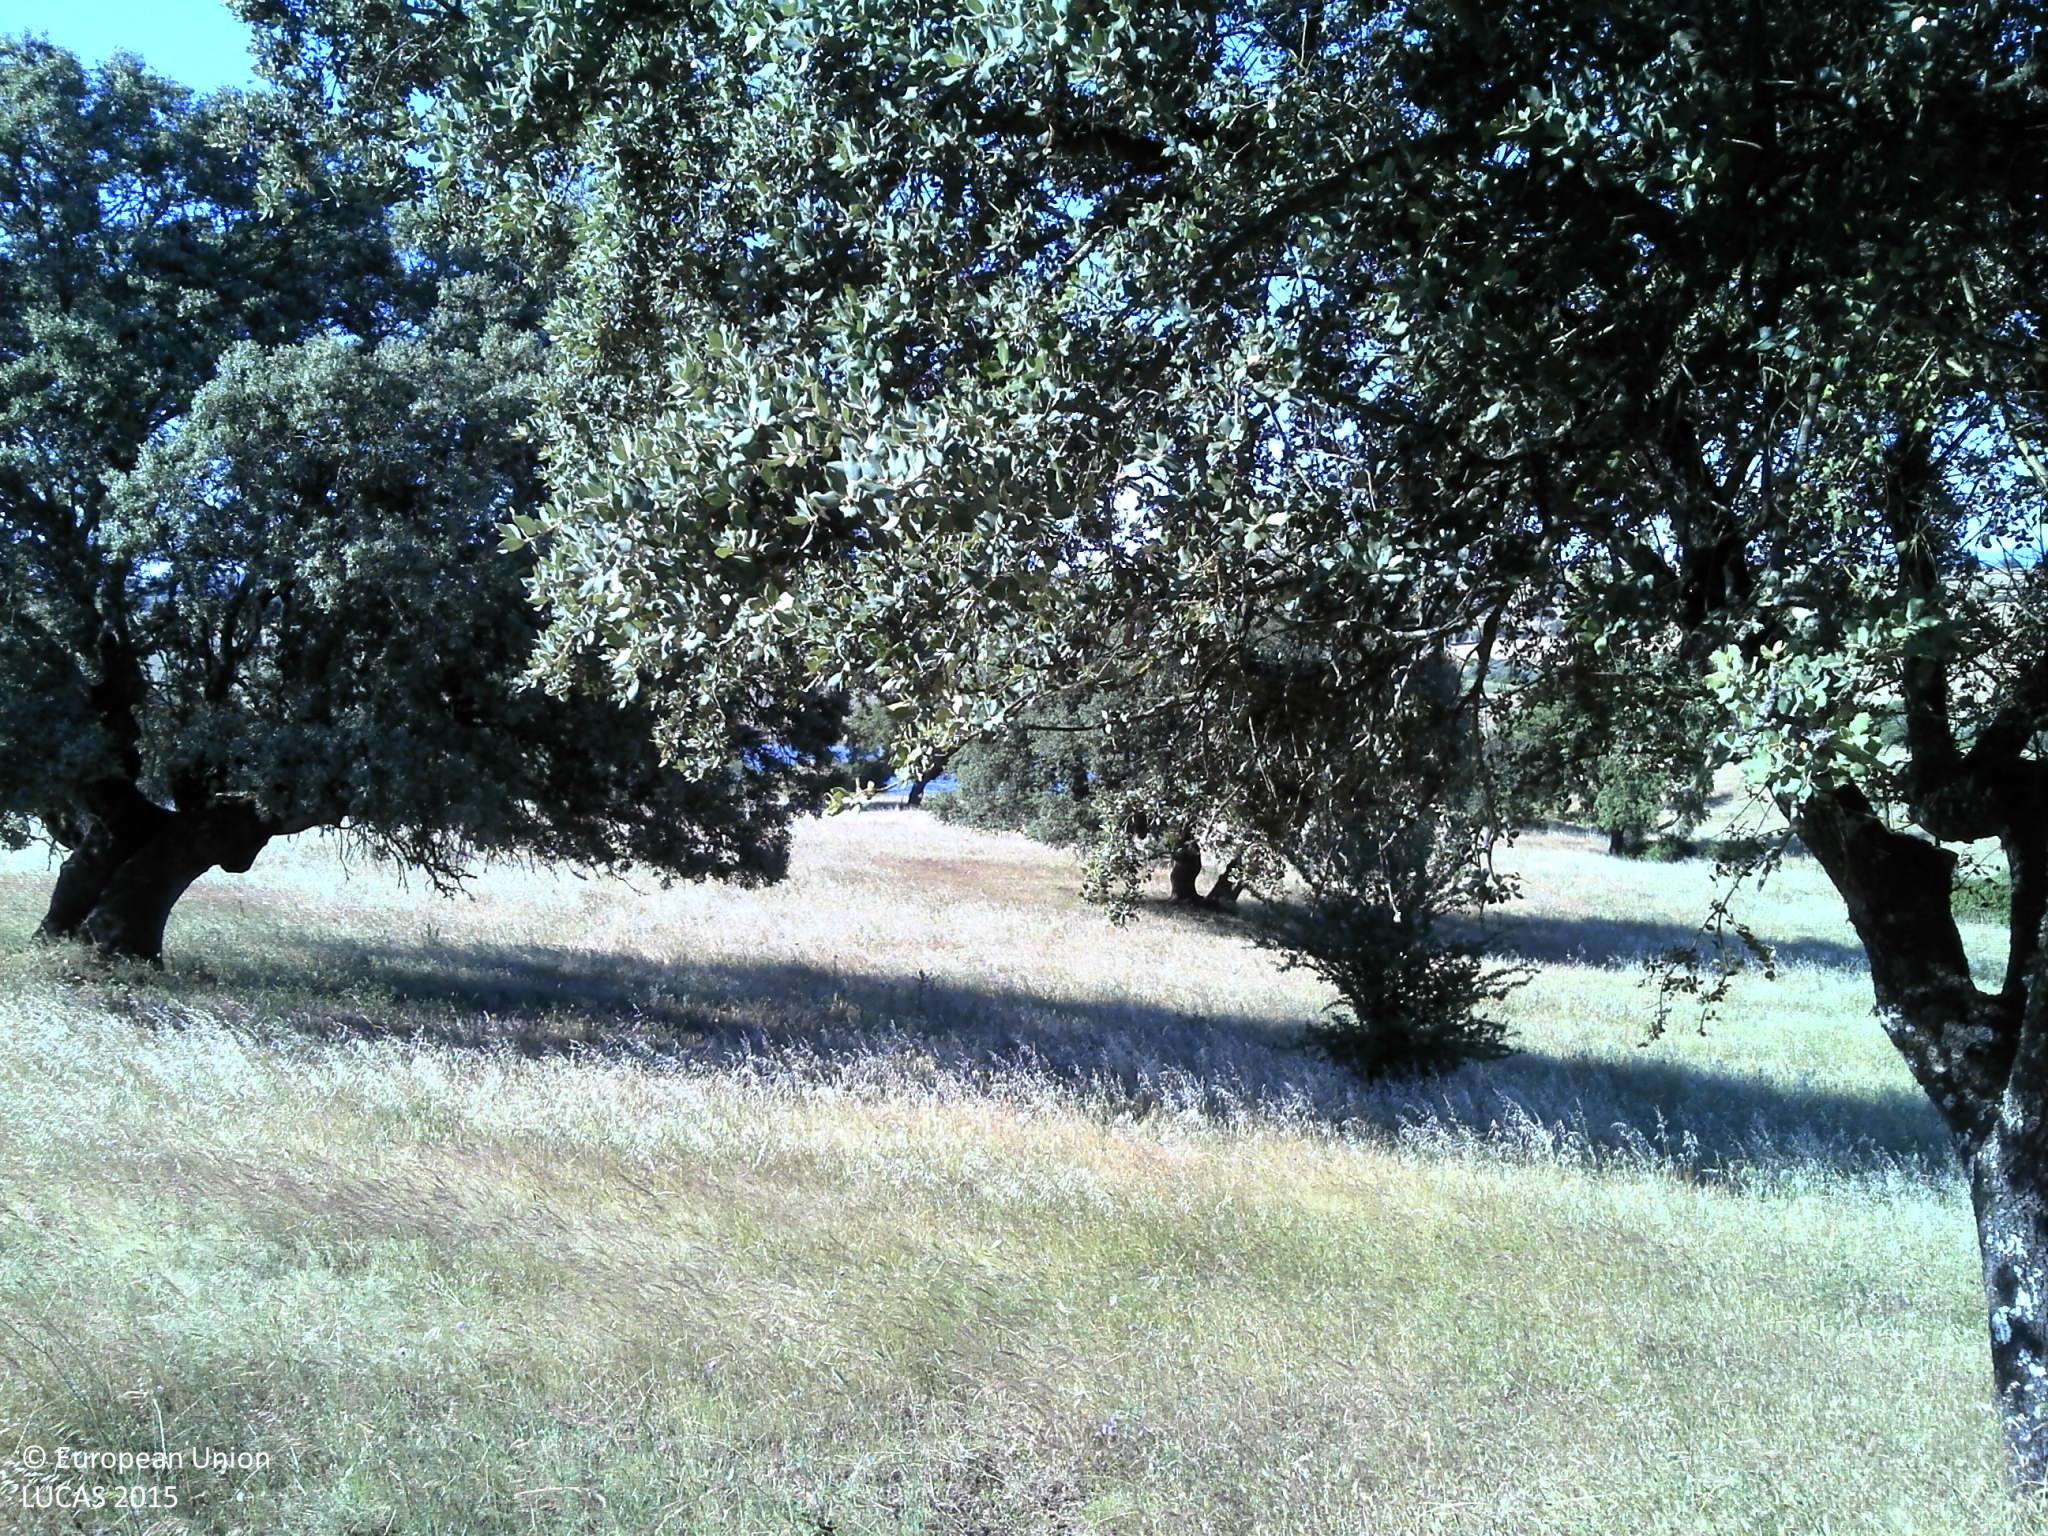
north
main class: Woodland
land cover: Broadleaved woodland
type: broadleaved evergreen forest
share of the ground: 10 - 25 %
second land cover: Grassland without tree/shrub cover
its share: 10 - 25 %
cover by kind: unconsolidated bare surface 50 %, herbaceous plants 30 %, broadleaved forest trees 15 %, shrubs 5 %
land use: Forestry
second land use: Agriculture (excluding fallow land and kitchen gardens)
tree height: > 5 m
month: May
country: PT
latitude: 39.2446
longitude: -7.6459
